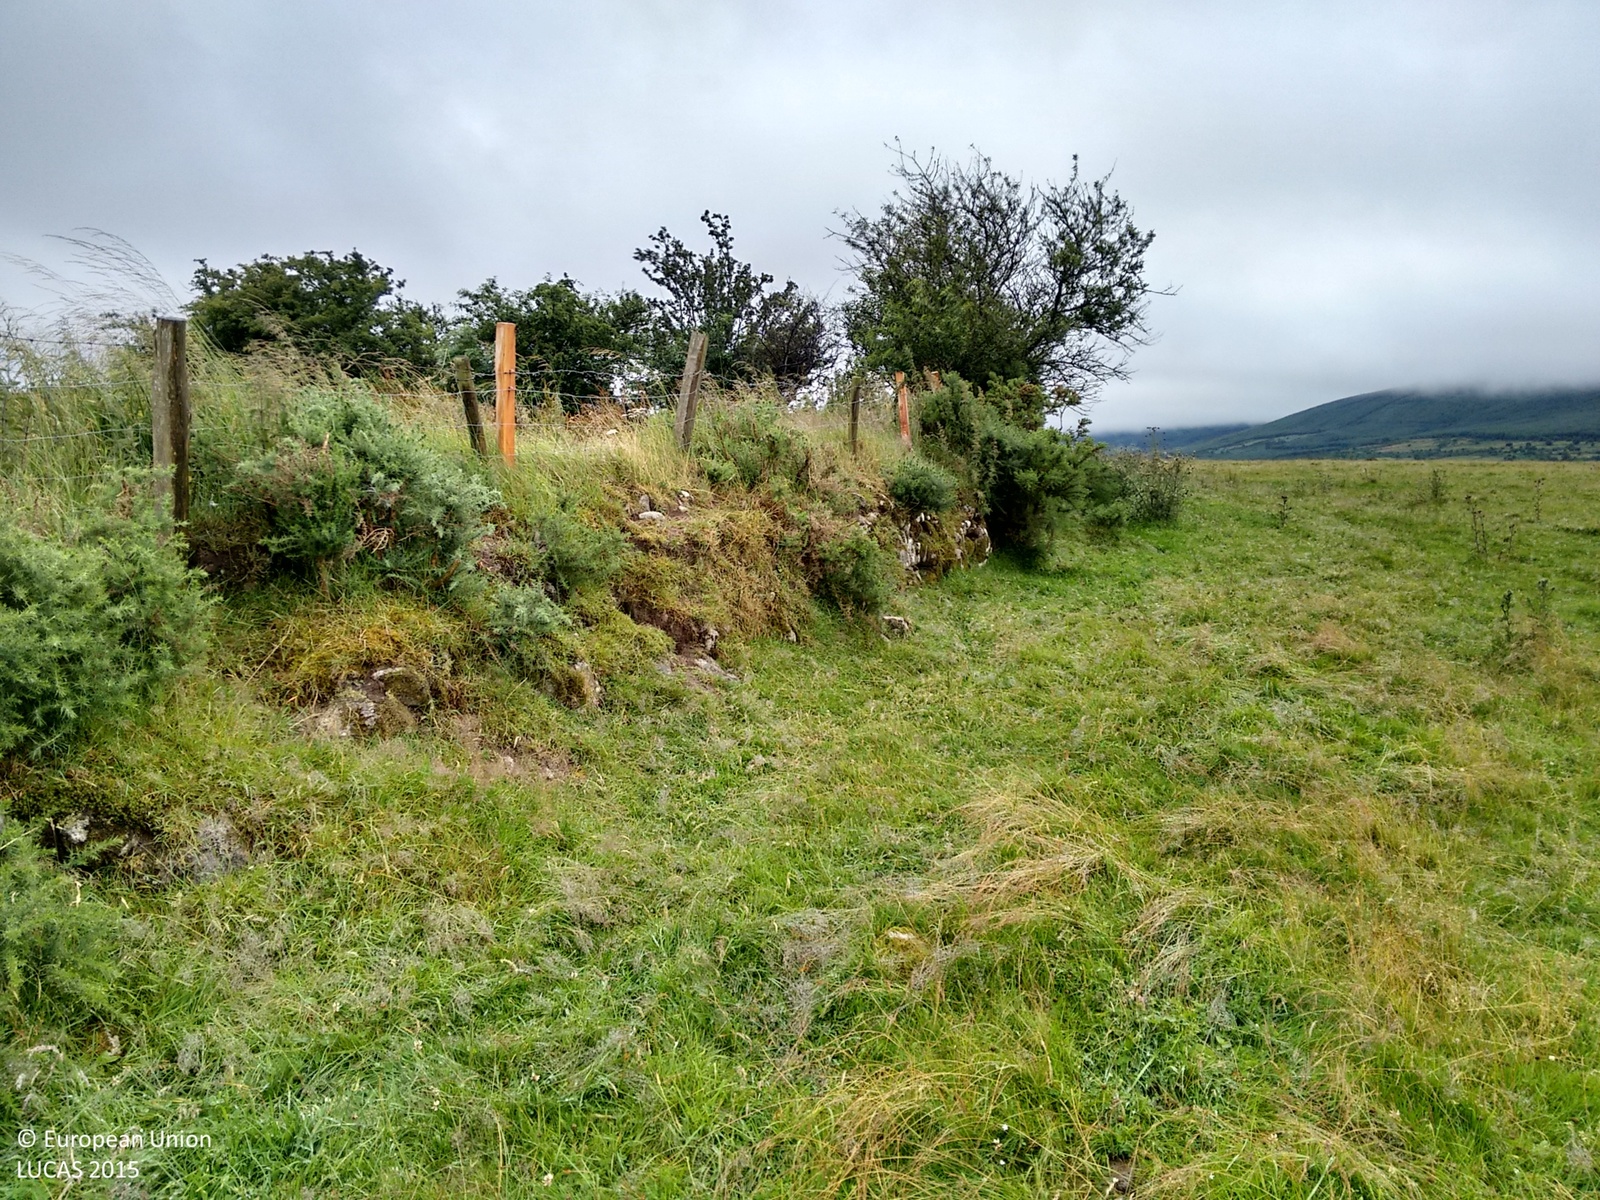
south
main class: Grassland
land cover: Grassland without tree/shrub cover
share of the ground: > 75 %
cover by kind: herbaceous plants 100 %
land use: Agriculture (excluding fallow land and kitchen gardens)
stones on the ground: < 10 %
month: July
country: IE
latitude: 53.0806
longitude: -6.5346
